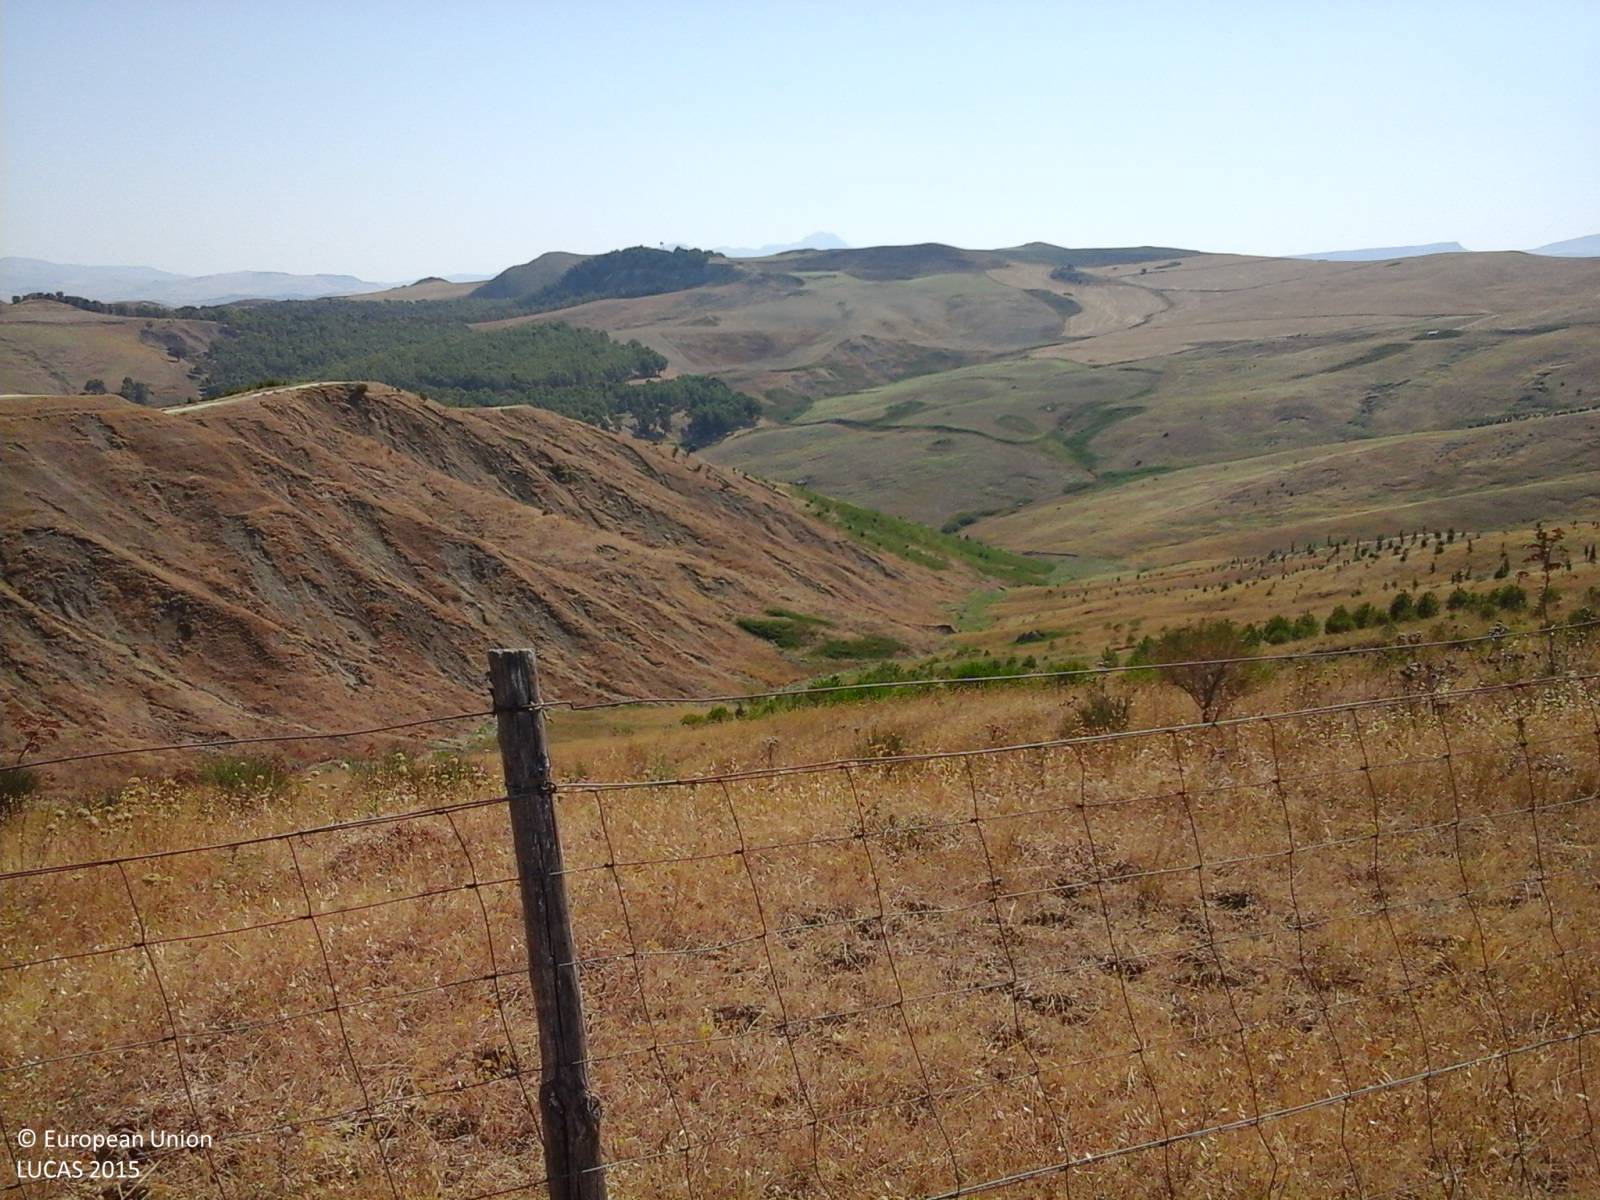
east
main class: Grassland
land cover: Grassland without tree/shrub cover
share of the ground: > 75 %
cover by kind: herbaceous plants 100 %
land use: Semi-natural and natural areas not in use
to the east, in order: Grassland without tree/shrub cover; Other coniferous woodland
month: July
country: IT
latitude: 37.7864
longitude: 13.1449
